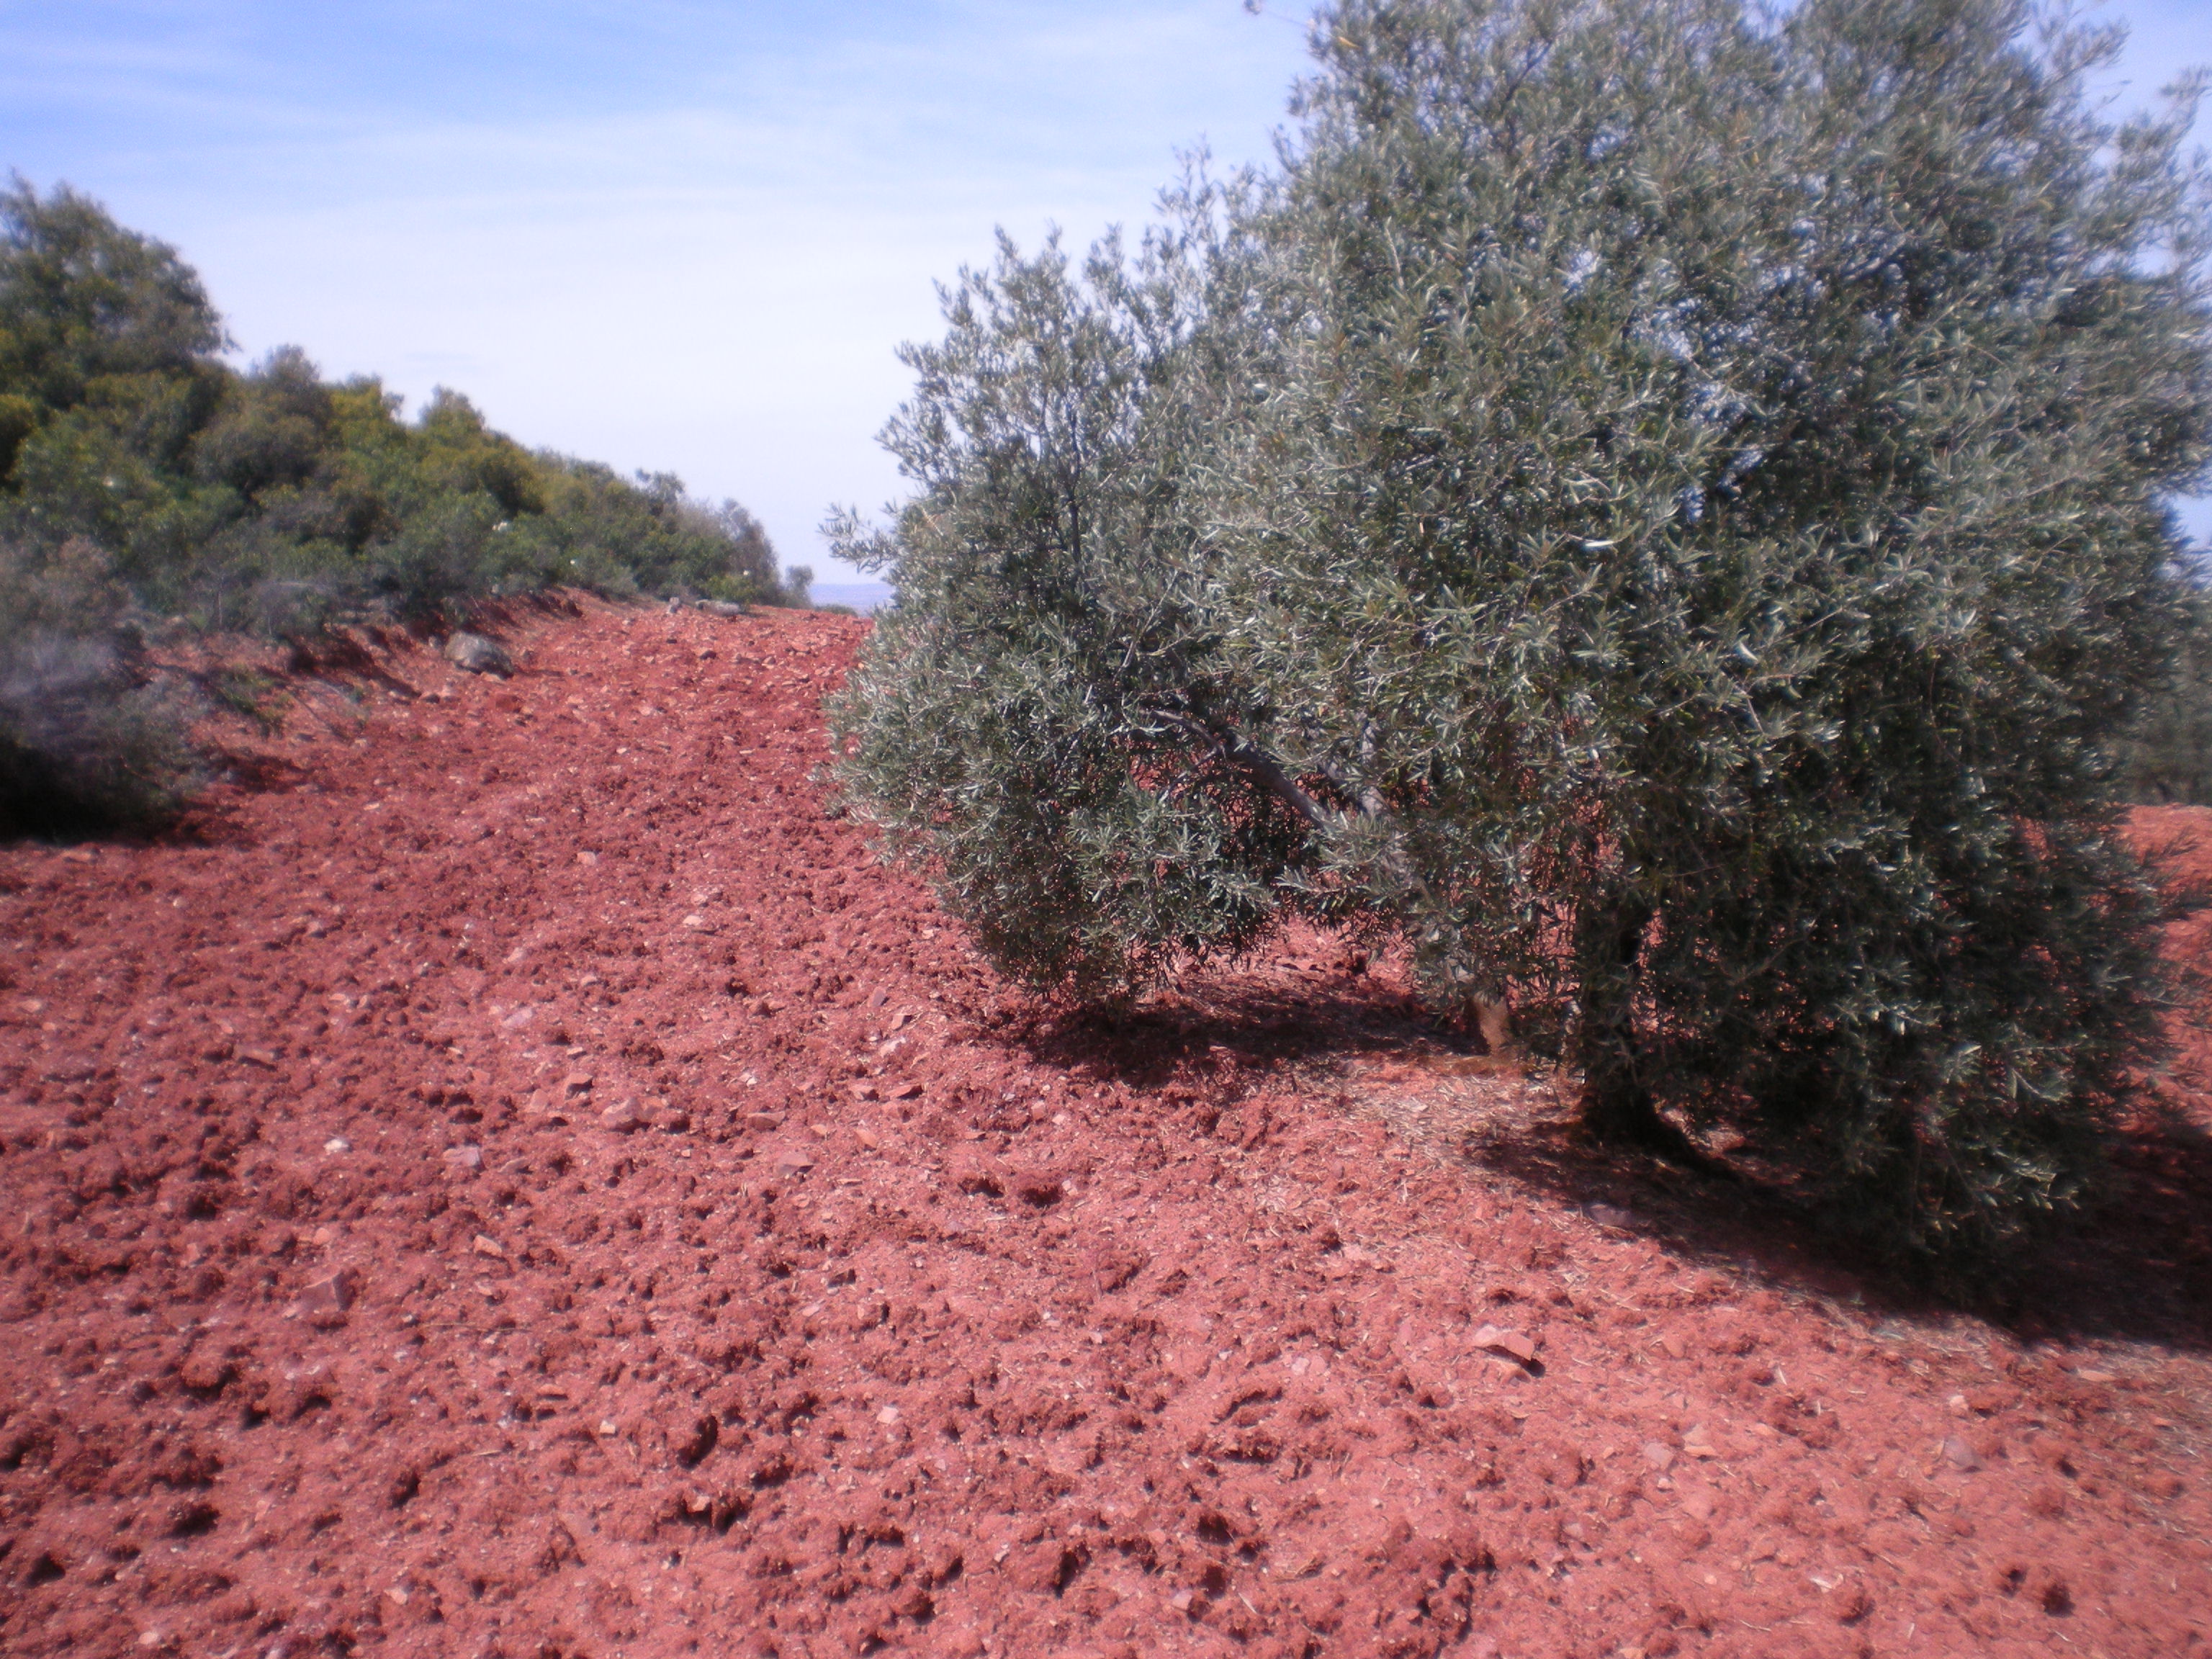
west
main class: Cropland
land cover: Olive groves
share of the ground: < 10 %
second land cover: Other bare soil
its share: > 75 %
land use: Agriculture (excluding fallow land and kitchen gardens)
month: April
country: ES
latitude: 38.8576
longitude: -3.2050
